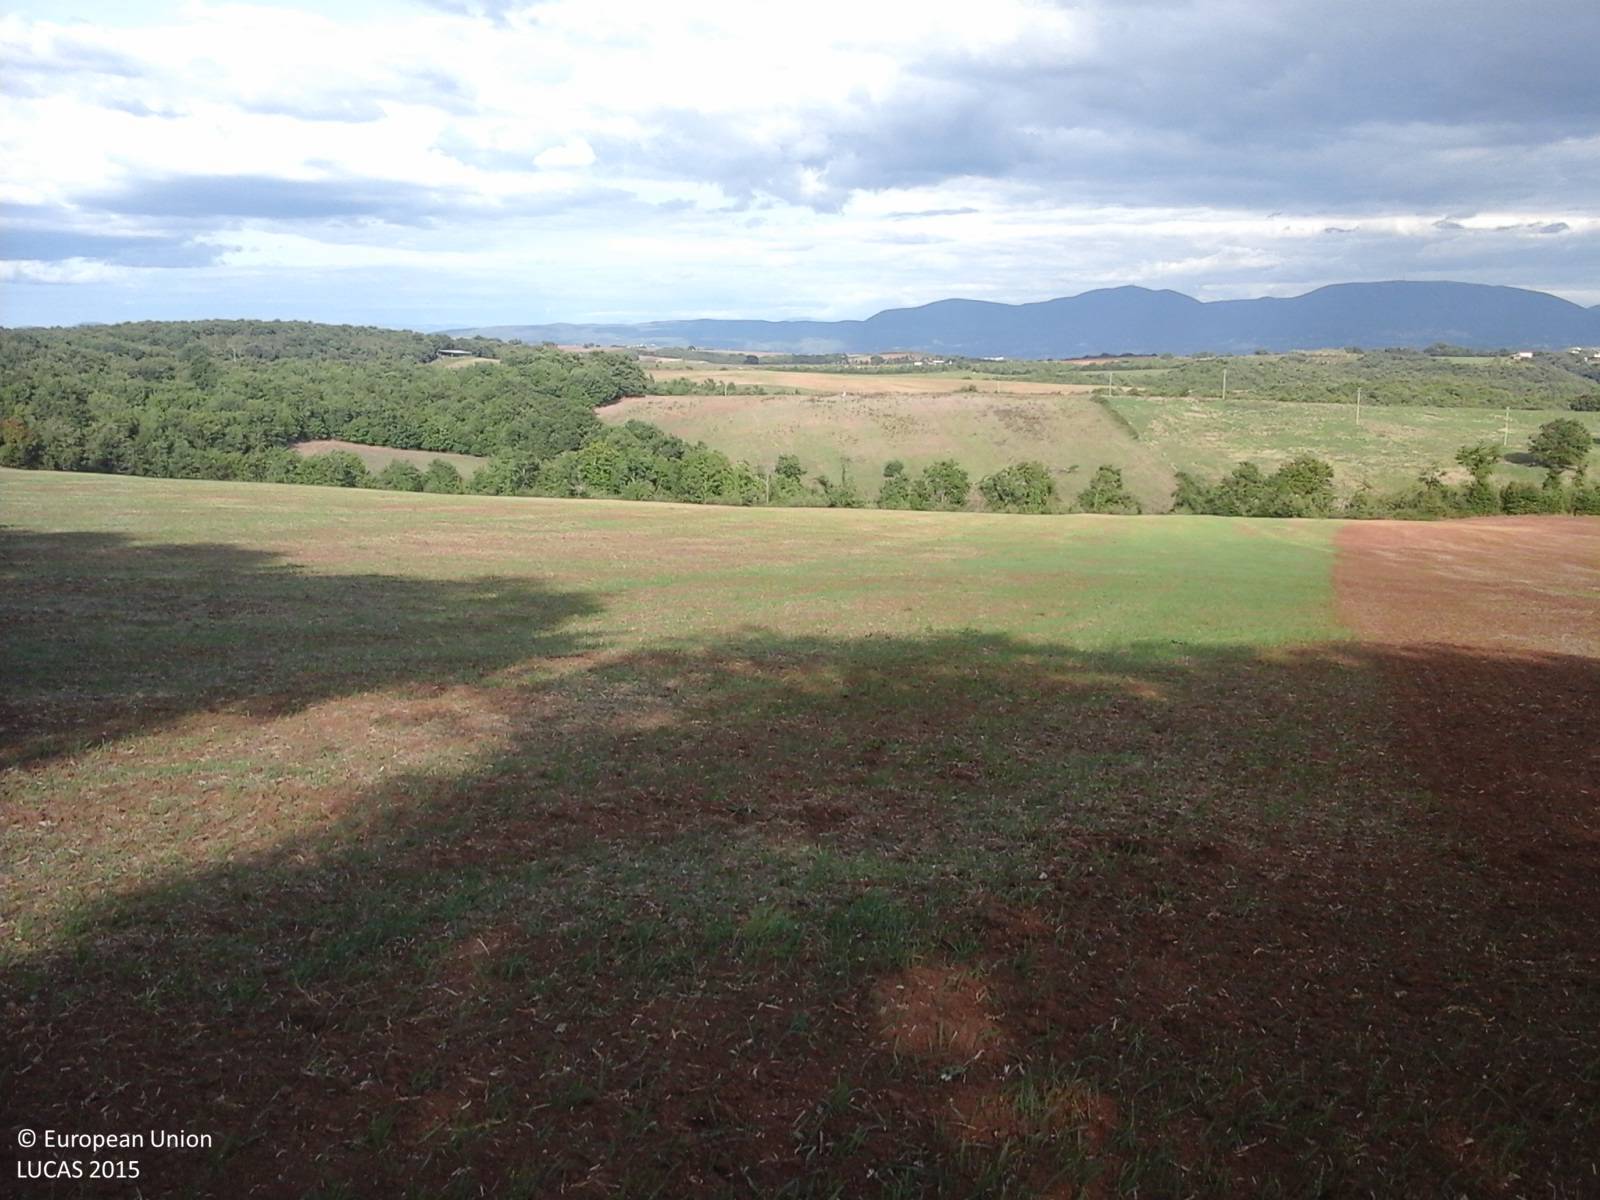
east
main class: Cropland
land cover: Oats
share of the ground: < 10 %
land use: Agriculture (excluding fallow land and kitchen gardens)
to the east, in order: Oats; Broadleaved woodland
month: September
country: IT
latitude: 42.3910
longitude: 12.3850
